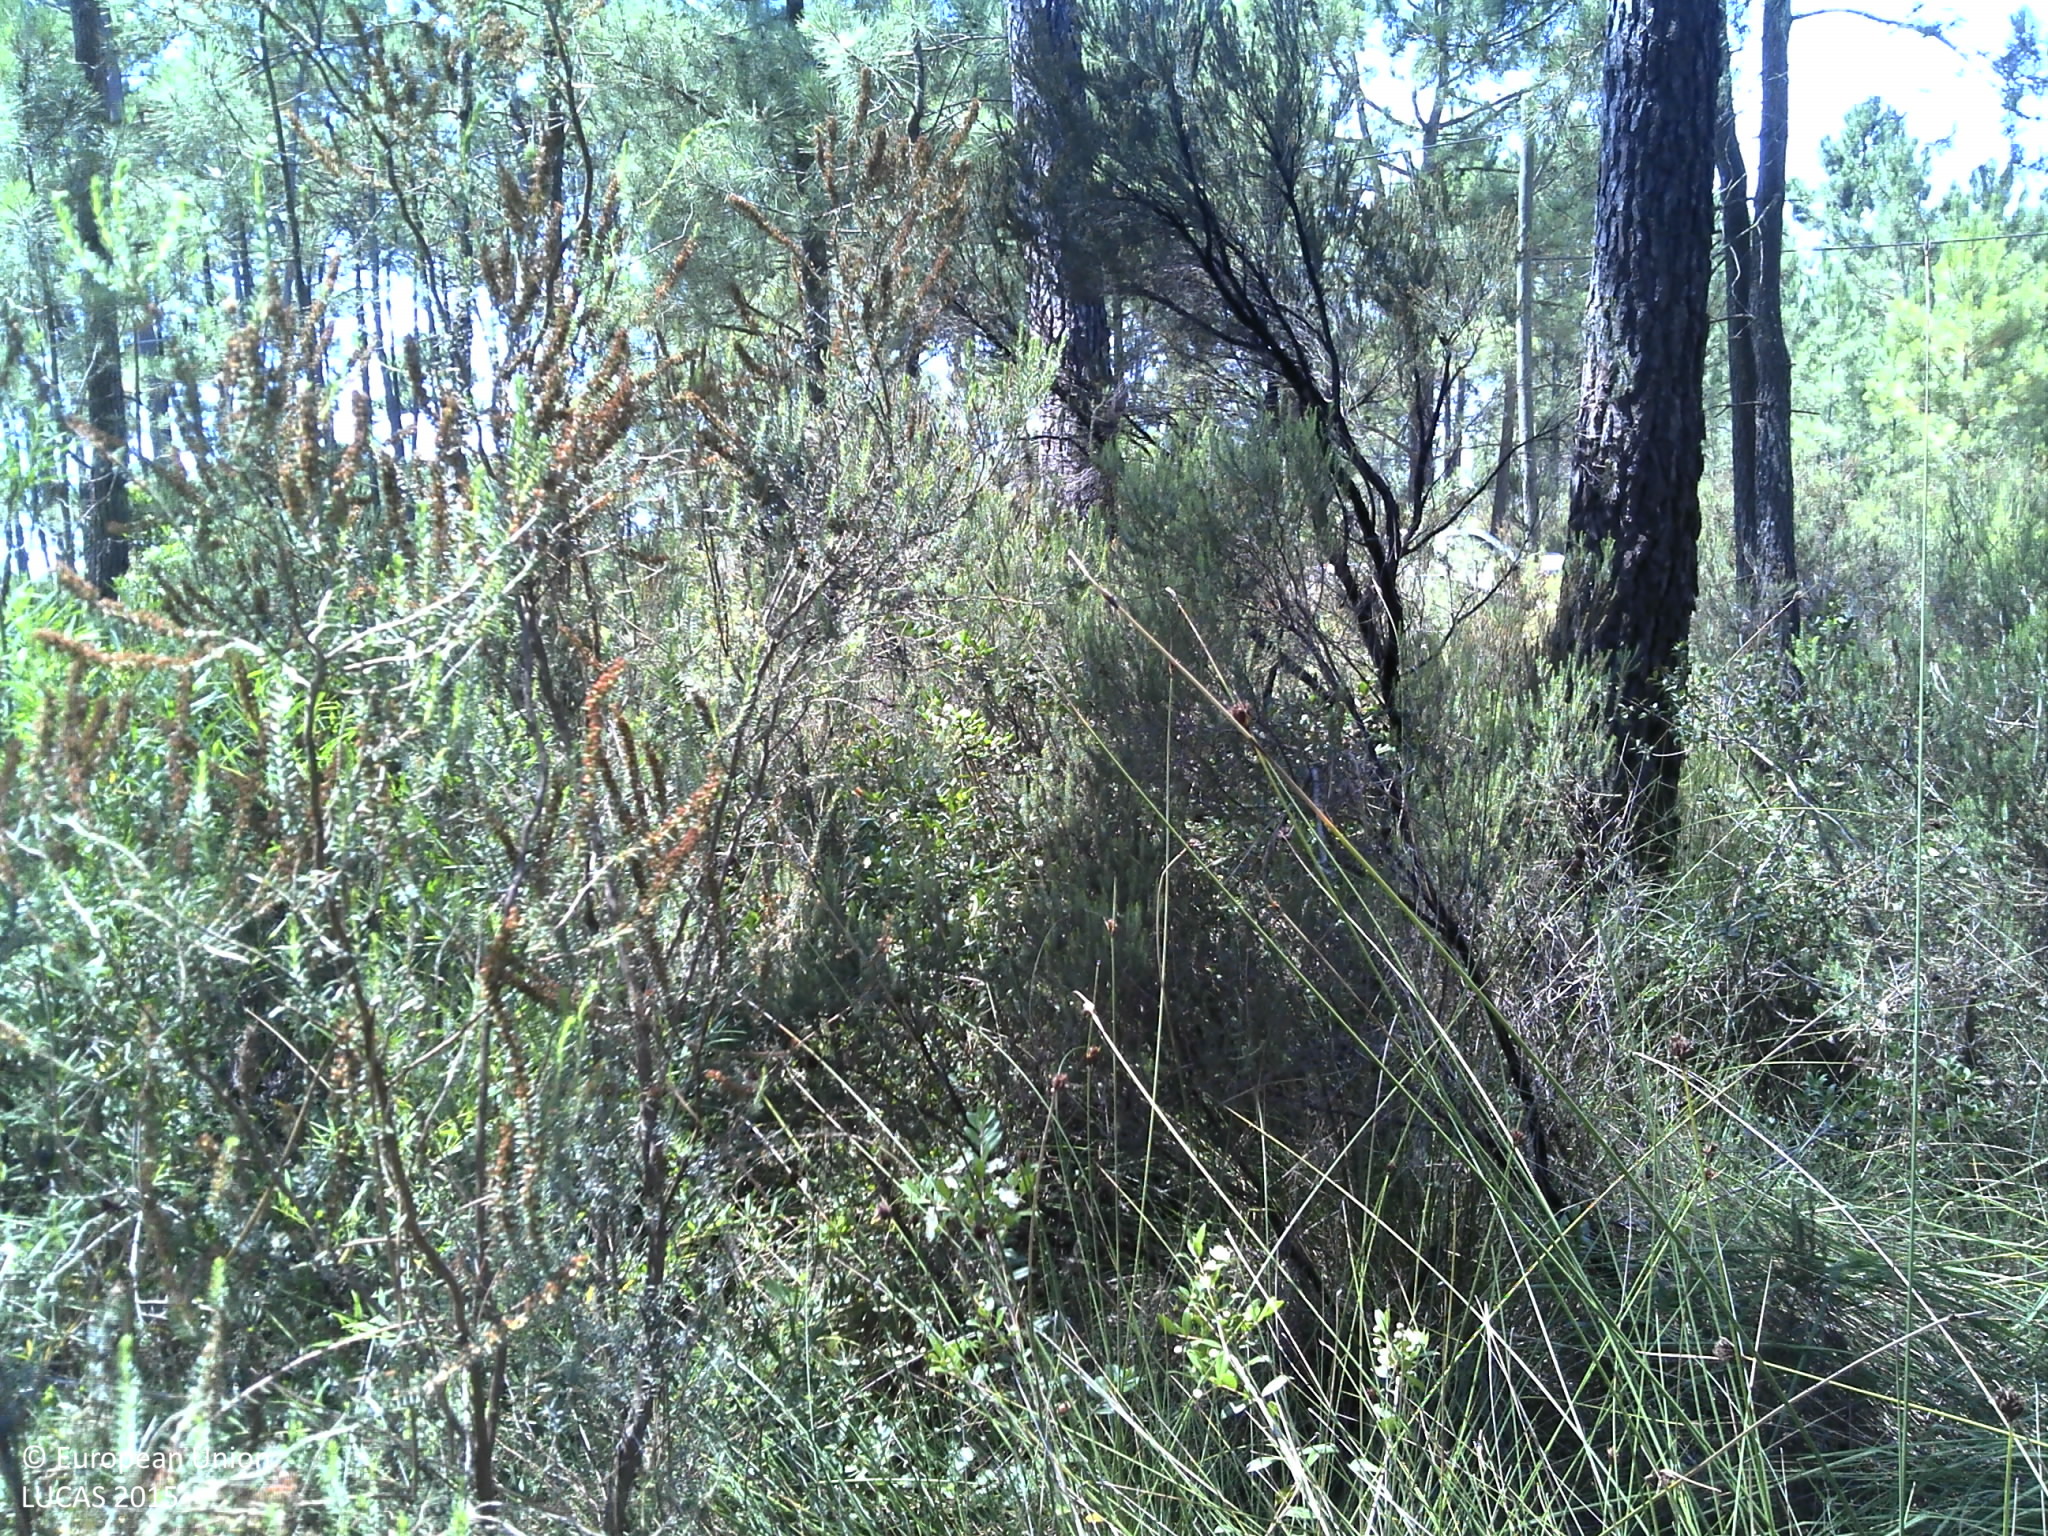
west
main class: Woodland
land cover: Pine dominated coniferous woodland
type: coniferous forest of the mediterranean region
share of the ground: > 75 %
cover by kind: coniferous forest trees 75 %, herbaceous plants 10 %, lichens and mosses 10 %, unconsolidated bare surface 5 %
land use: Forestry
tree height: > 5 m
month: June
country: PT
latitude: 38.5722
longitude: -9.1131
